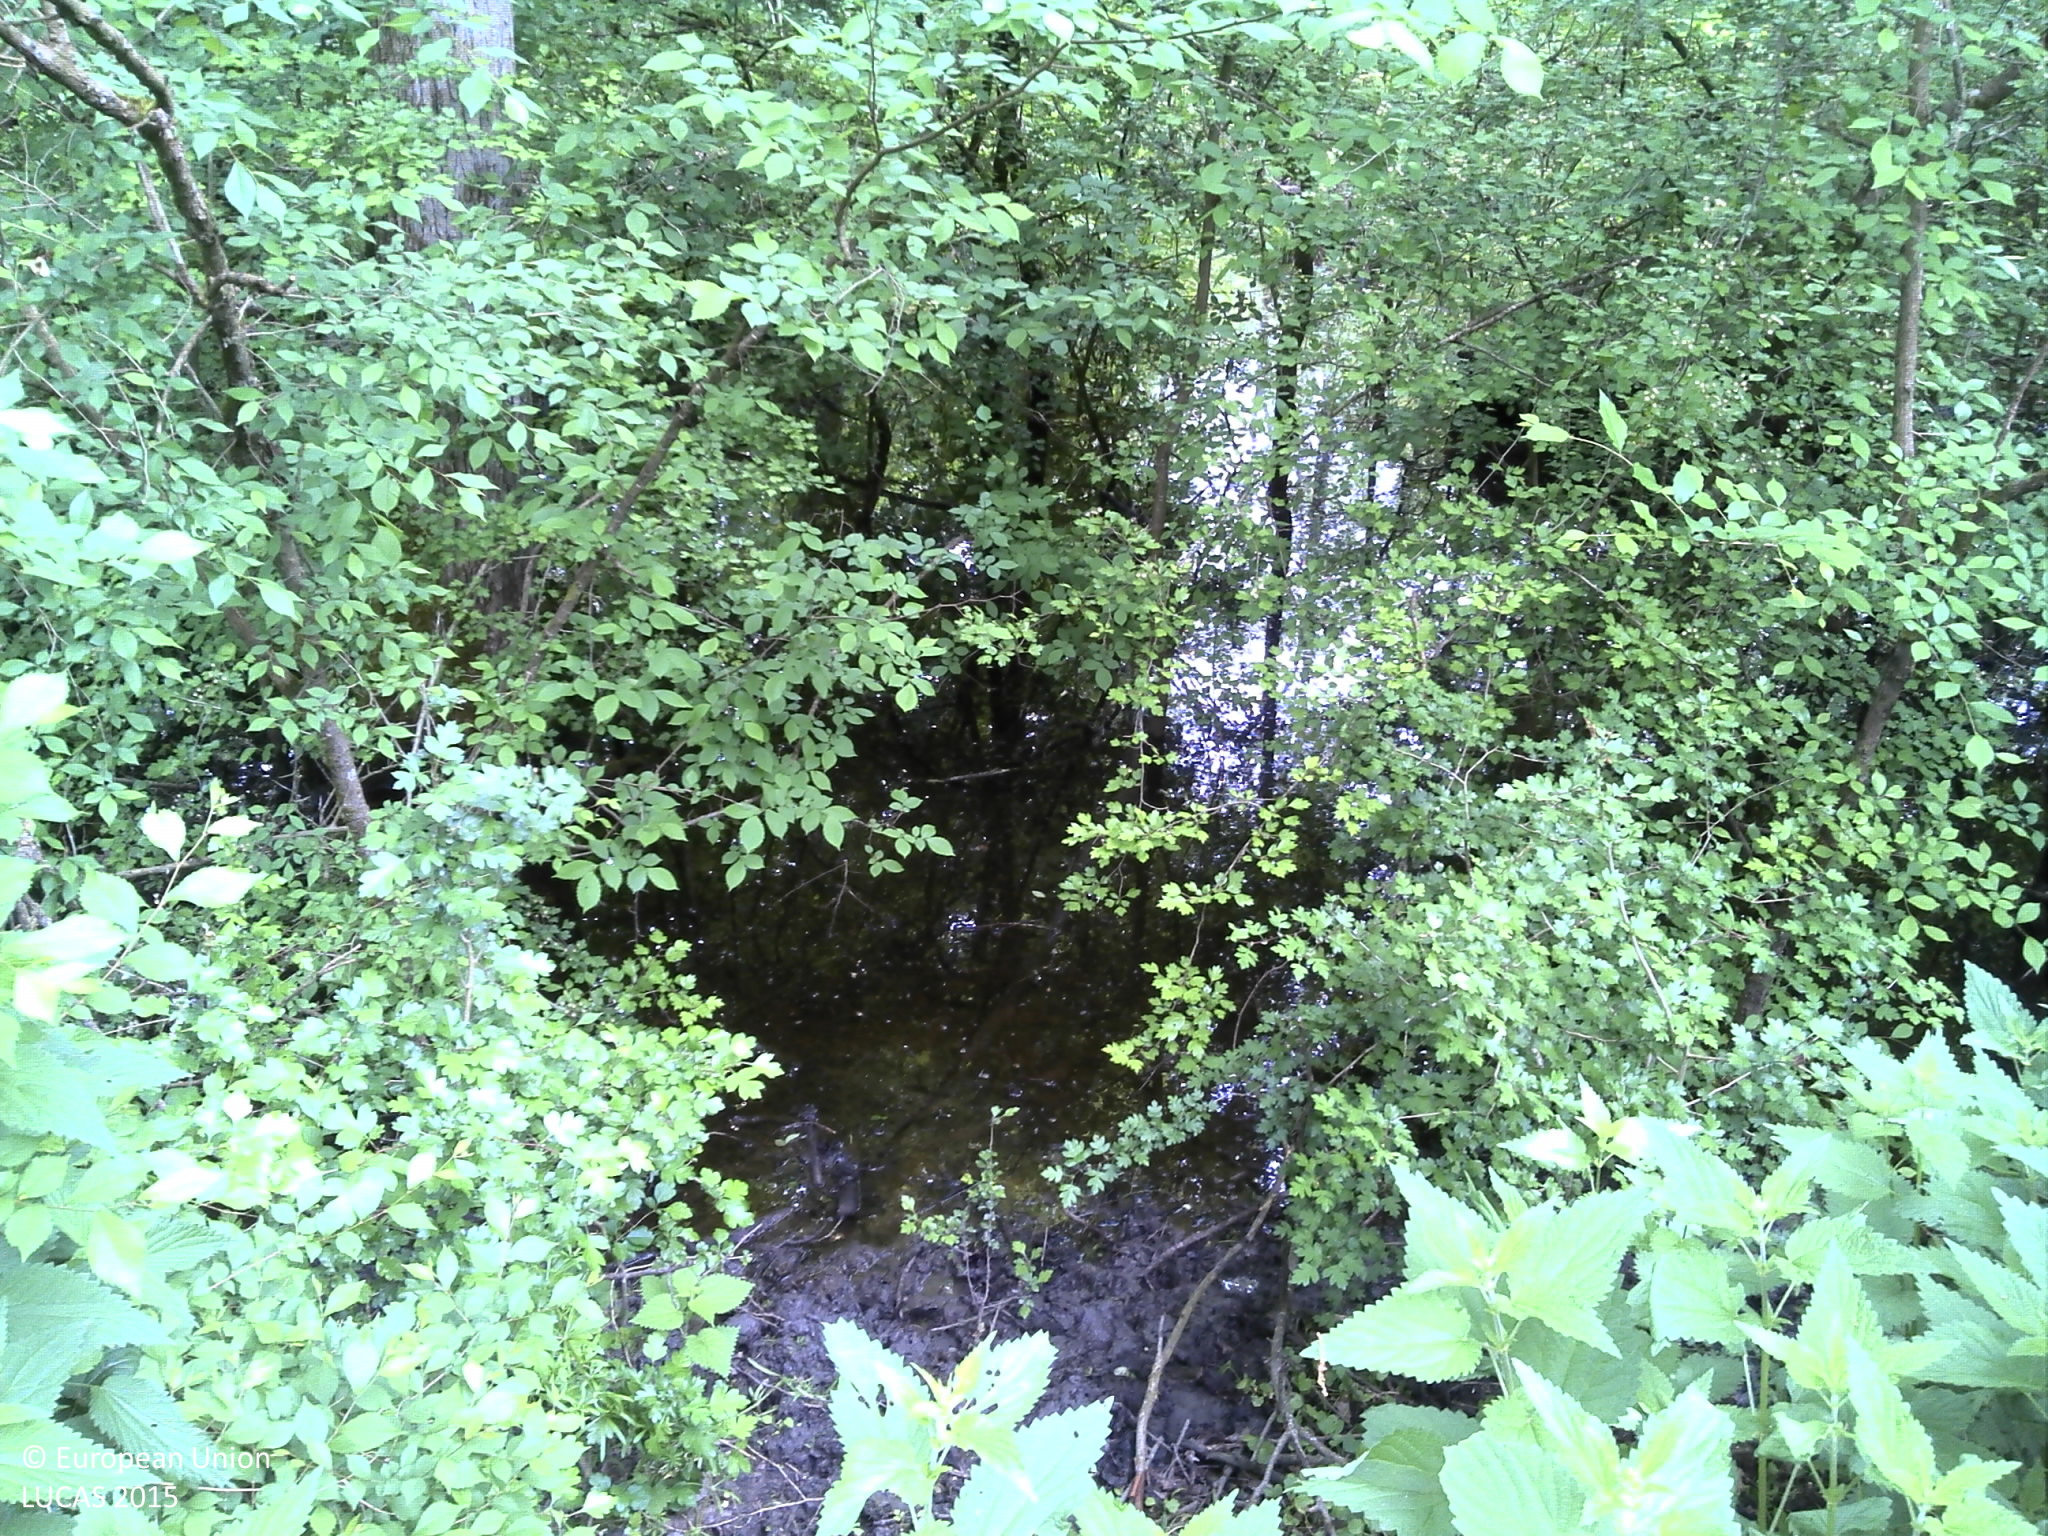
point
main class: Woodland
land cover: Broadleaved woodland
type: mesophytic deciduous forest
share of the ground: > 75 %
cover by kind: broadleaved forest trees 100 %
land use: Forestry
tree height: > 5 m
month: May
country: HR
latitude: 45.0254
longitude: 18.8267
